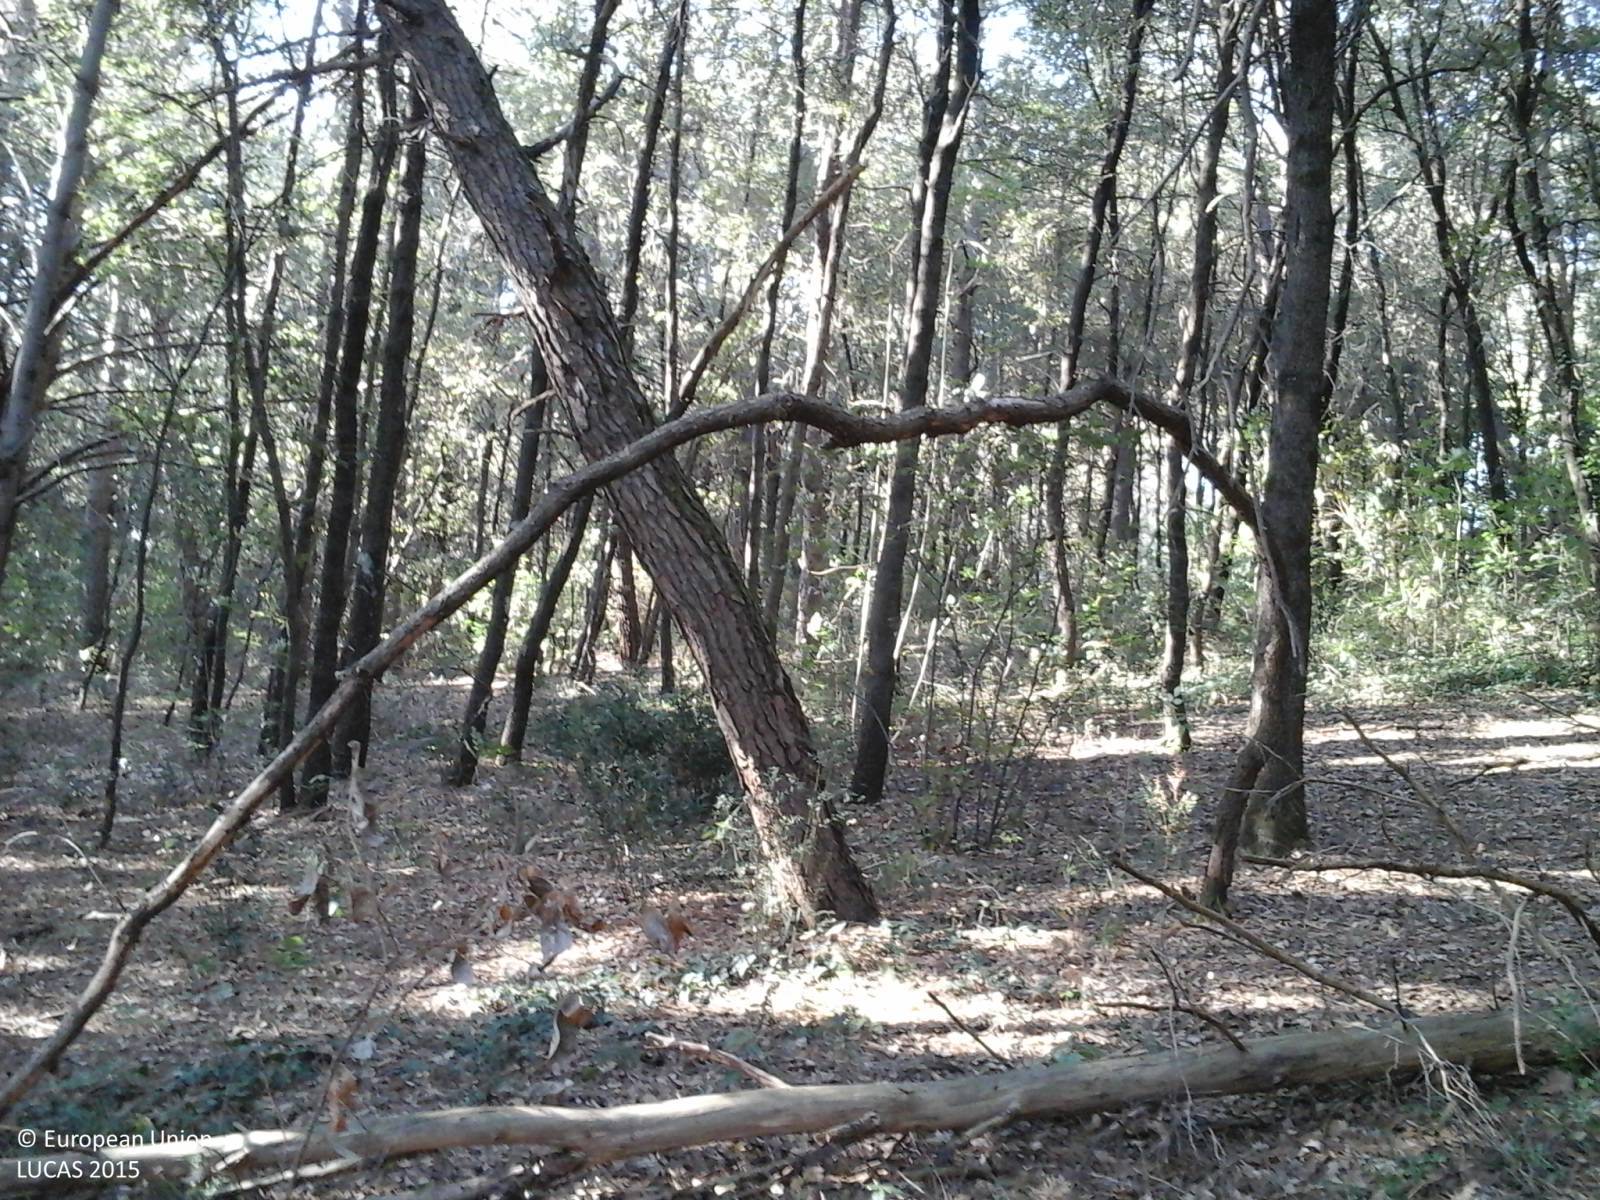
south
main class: Woodland
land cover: Other mixed woodland
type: thermophilous deciduous forest
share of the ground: > 75 %
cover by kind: coniferous forest trees 60 %, broadleaved forest trees 40 %
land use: Forestry
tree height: > 5 m
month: September
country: IT
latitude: 43.0967
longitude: 12.3398
